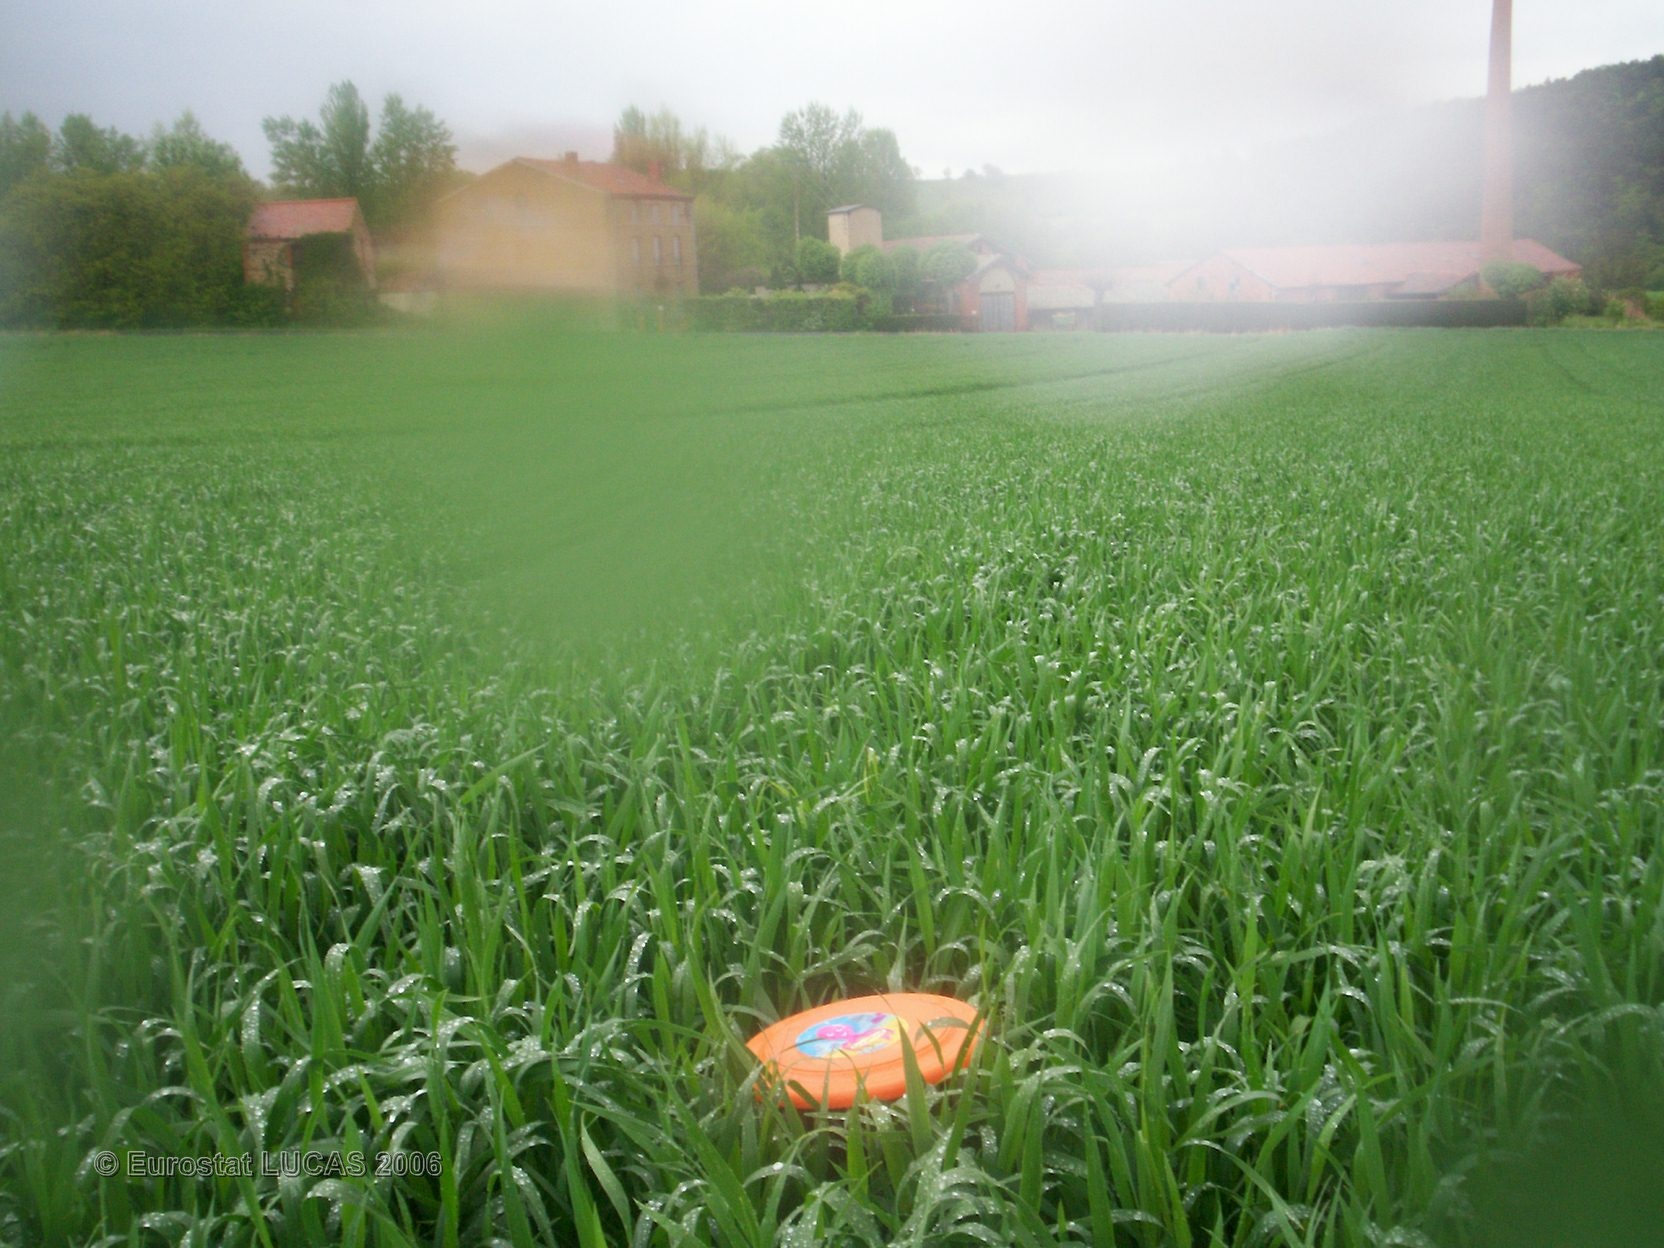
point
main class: Cropland
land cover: Common wheat
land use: Agriculture (excluding fallow land and kitchen gardens)
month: May
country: FR
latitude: 45.6050
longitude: 3.1152
